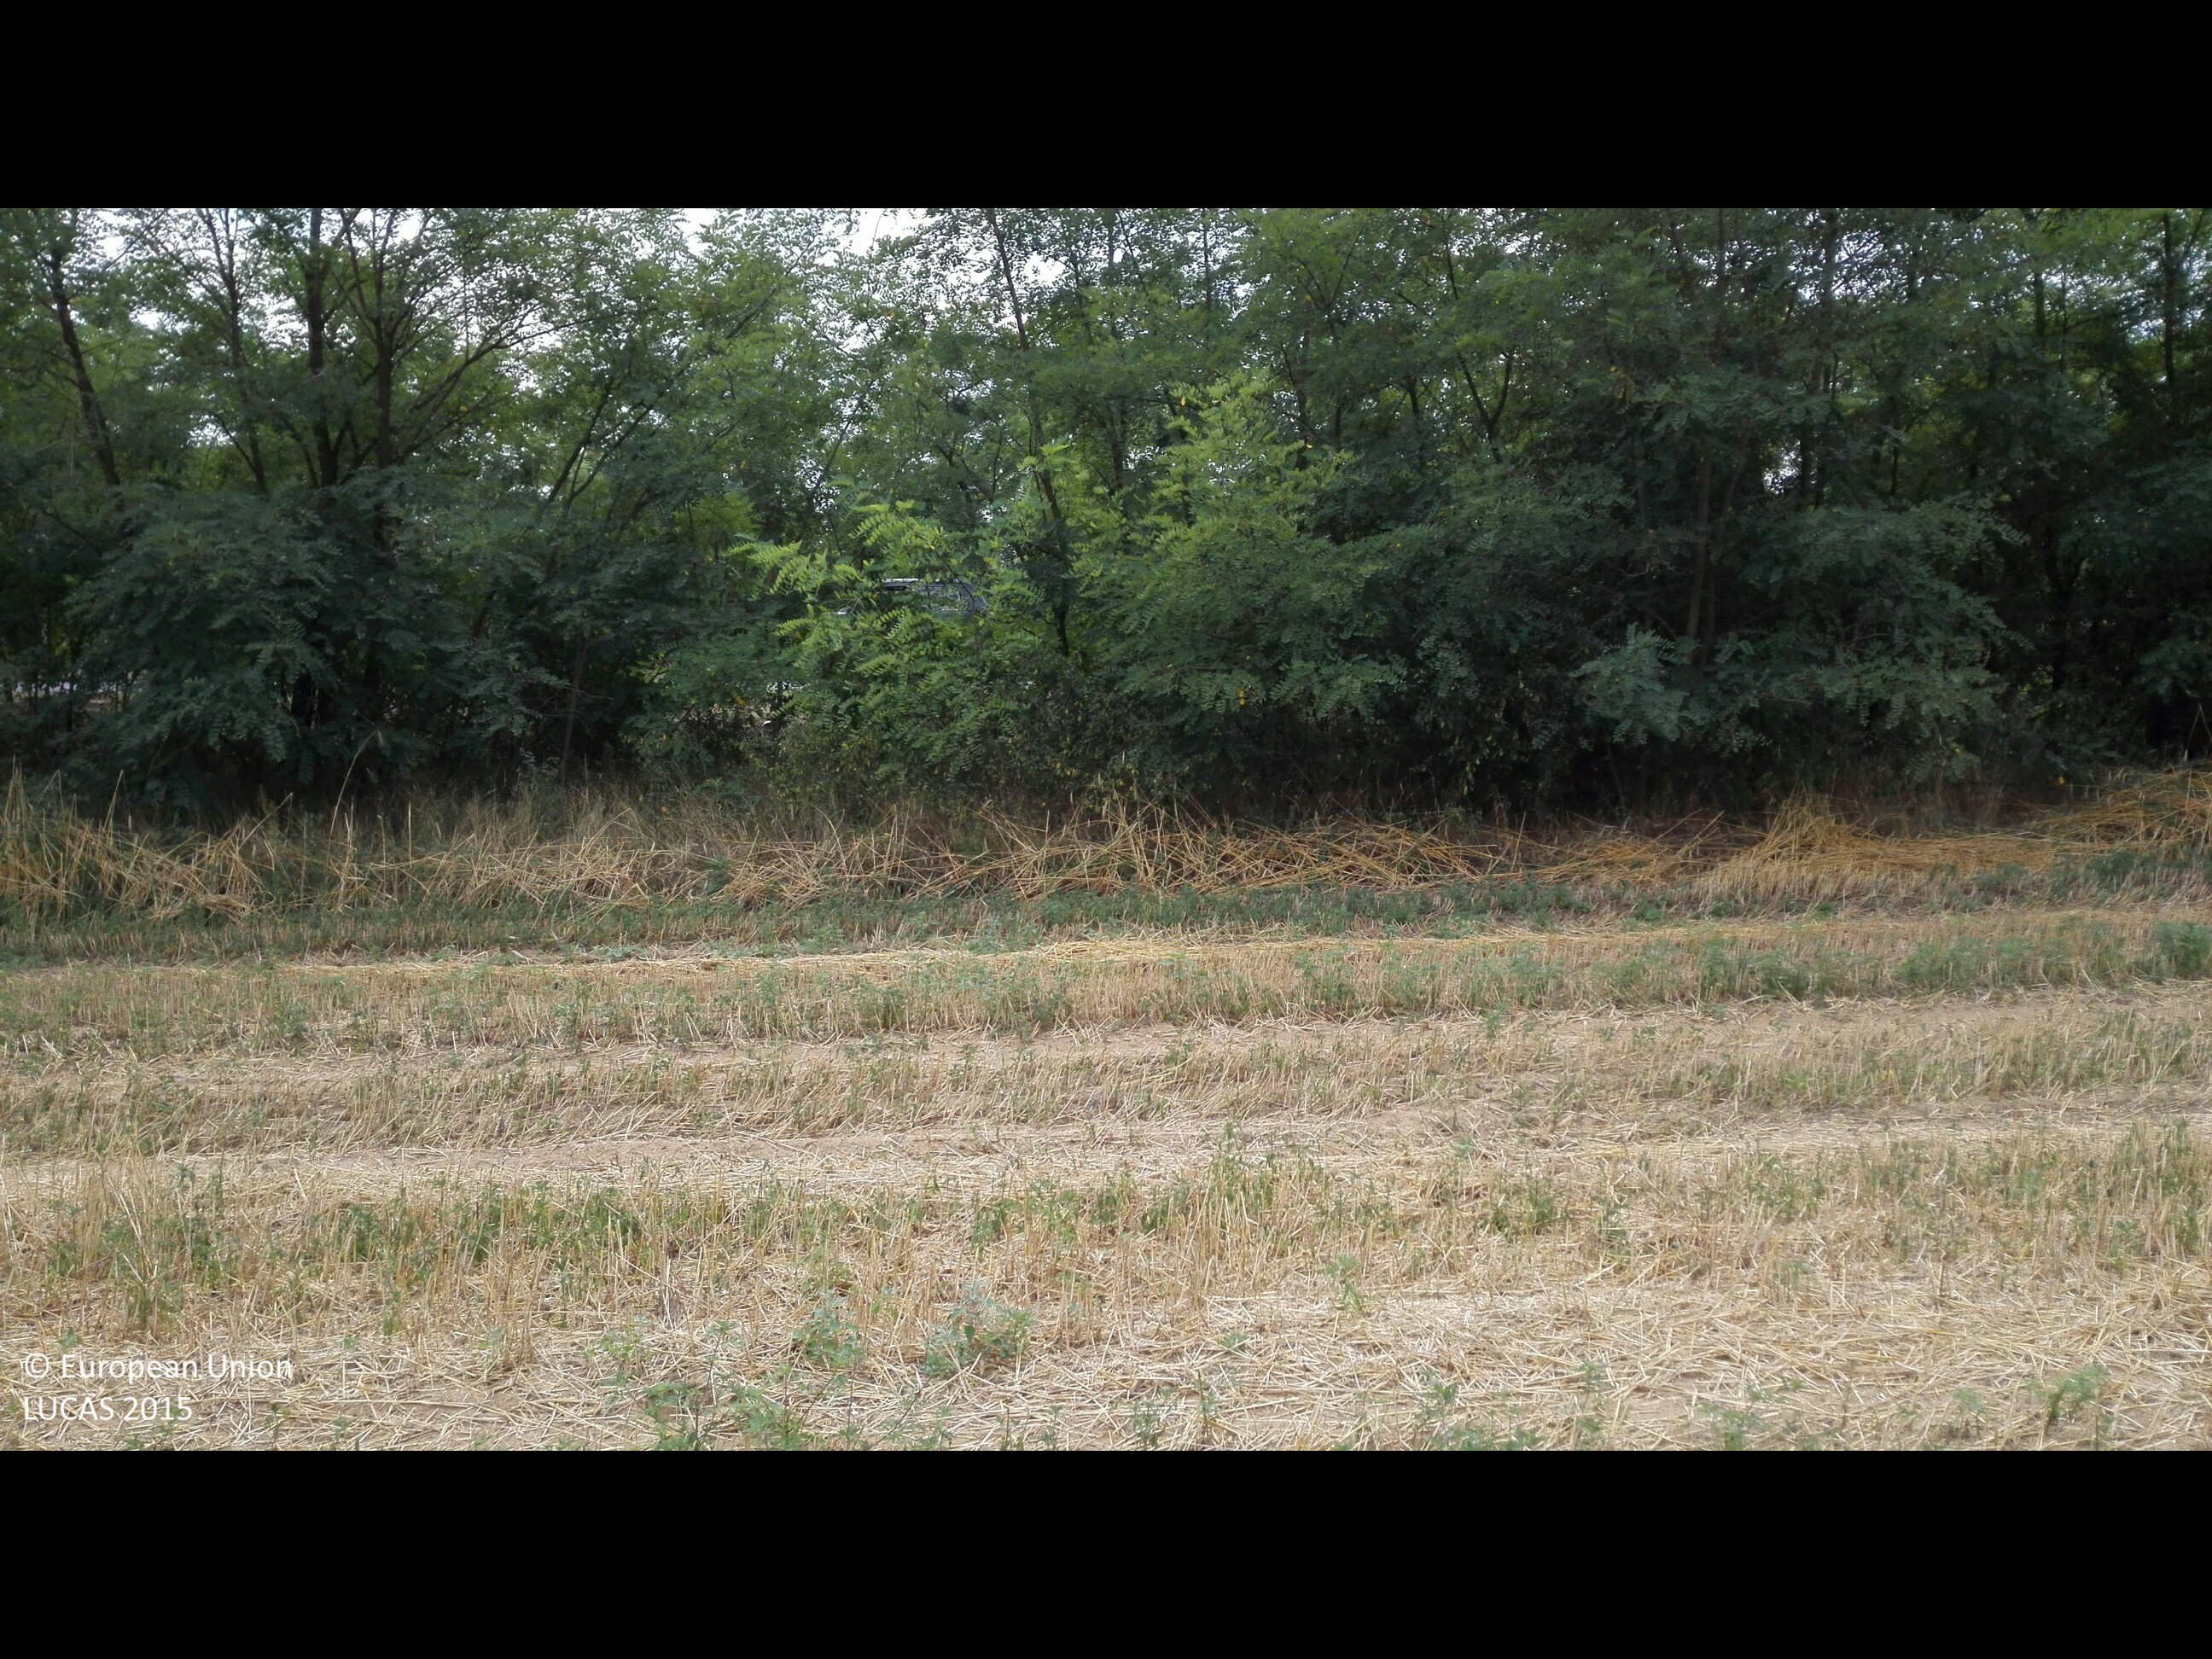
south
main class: Cropland
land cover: Rye
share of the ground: > 75 %
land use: Agriculture (excluding fallow land and kitchen gardens)
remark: Harvested field
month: August
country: HU
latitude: 47.5296
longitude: 21.8291
